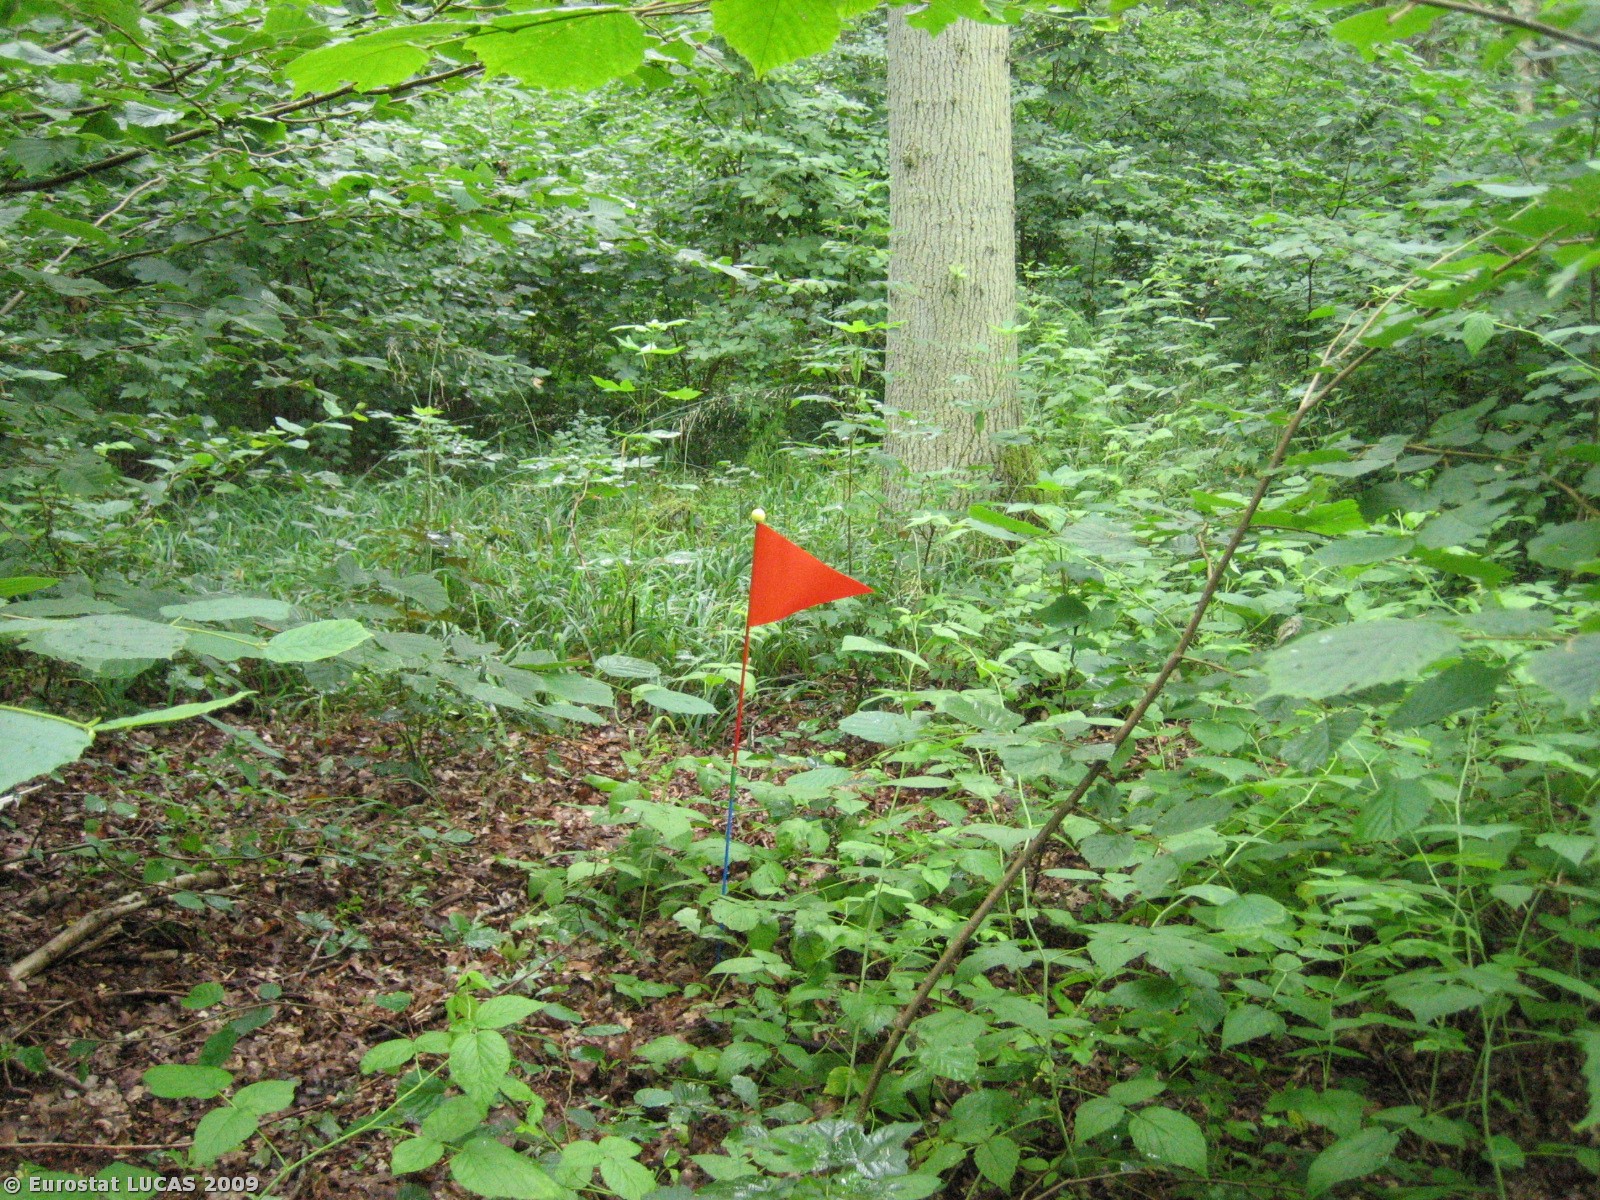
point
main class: Woodland
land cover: Broadleaved woodland
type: mesophytic deciduous forest
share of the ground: > 75 %
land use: Forestry
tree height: > 5 m
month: July
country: DK
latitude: 55.3609
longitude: 9.9212
